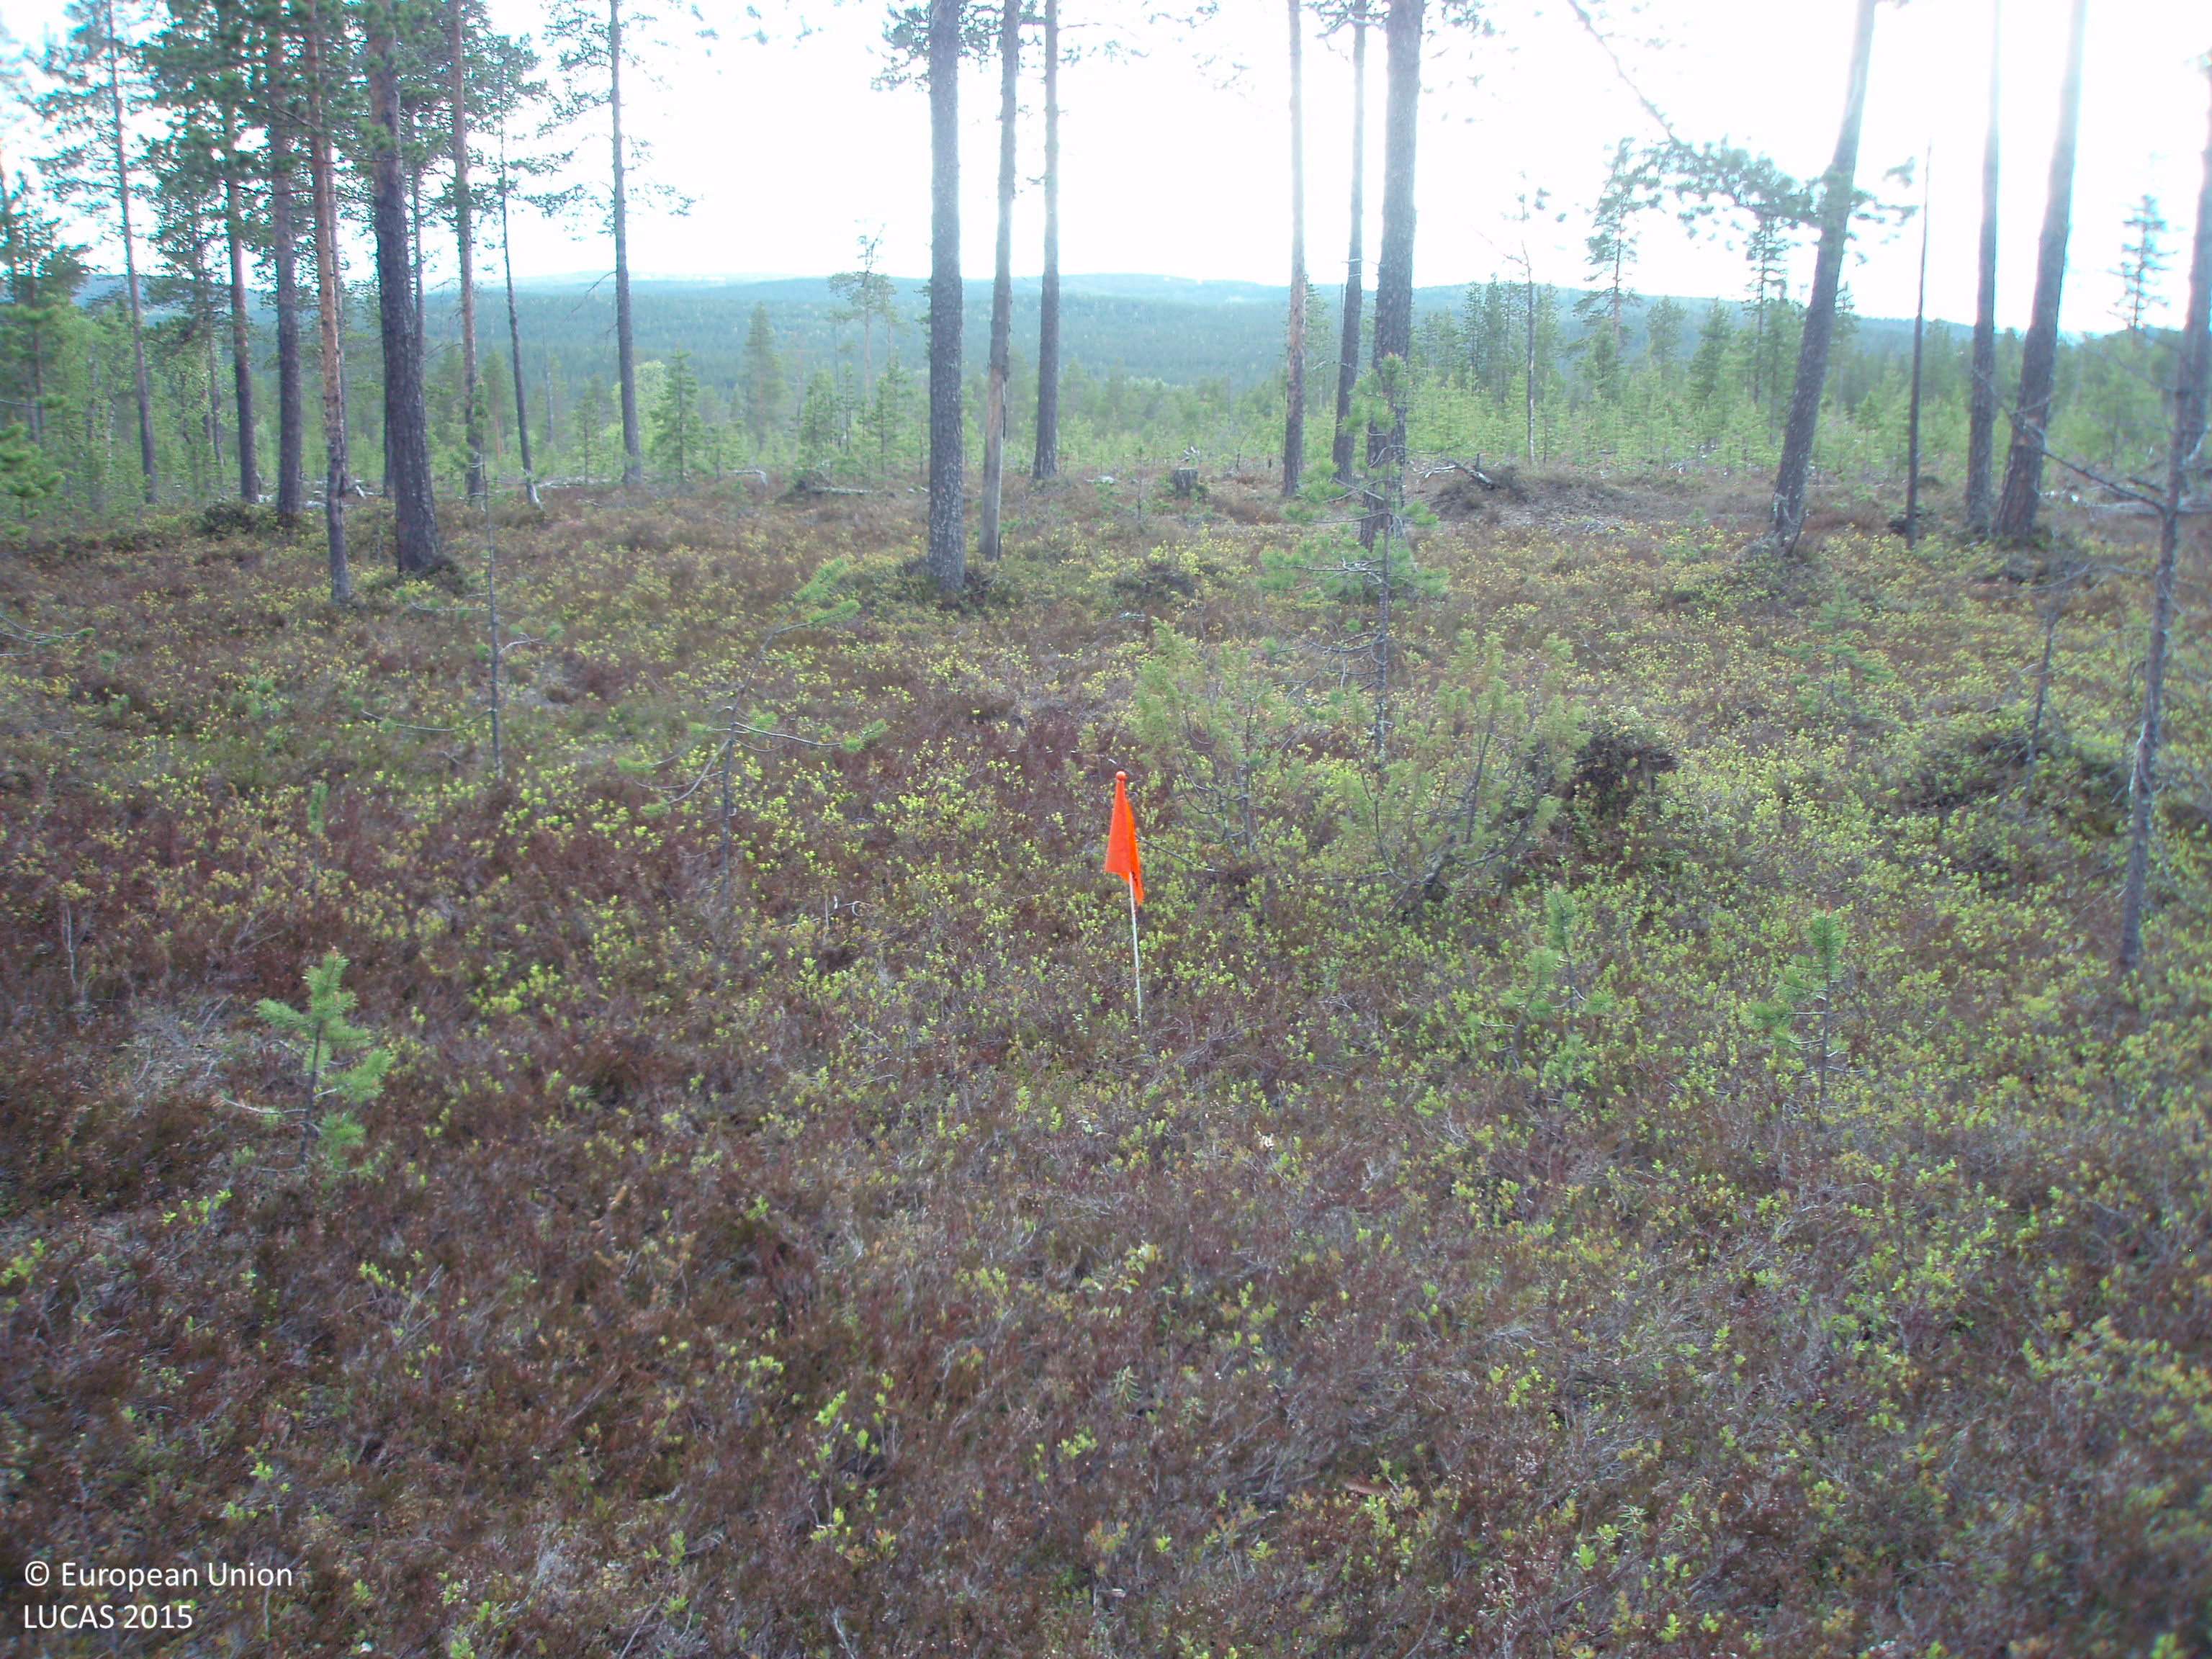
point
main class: Woodland
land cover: Pine dominated coniferous woodland
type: boreal forest
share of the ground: 25 - 50 %
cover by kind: shrubs 70 %, coniferous forest trees 25 %, lichens and mosses 5 %
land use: Forestry
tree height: > 5 m
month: June
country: FI
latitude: 68.4356
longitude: 27.8644
